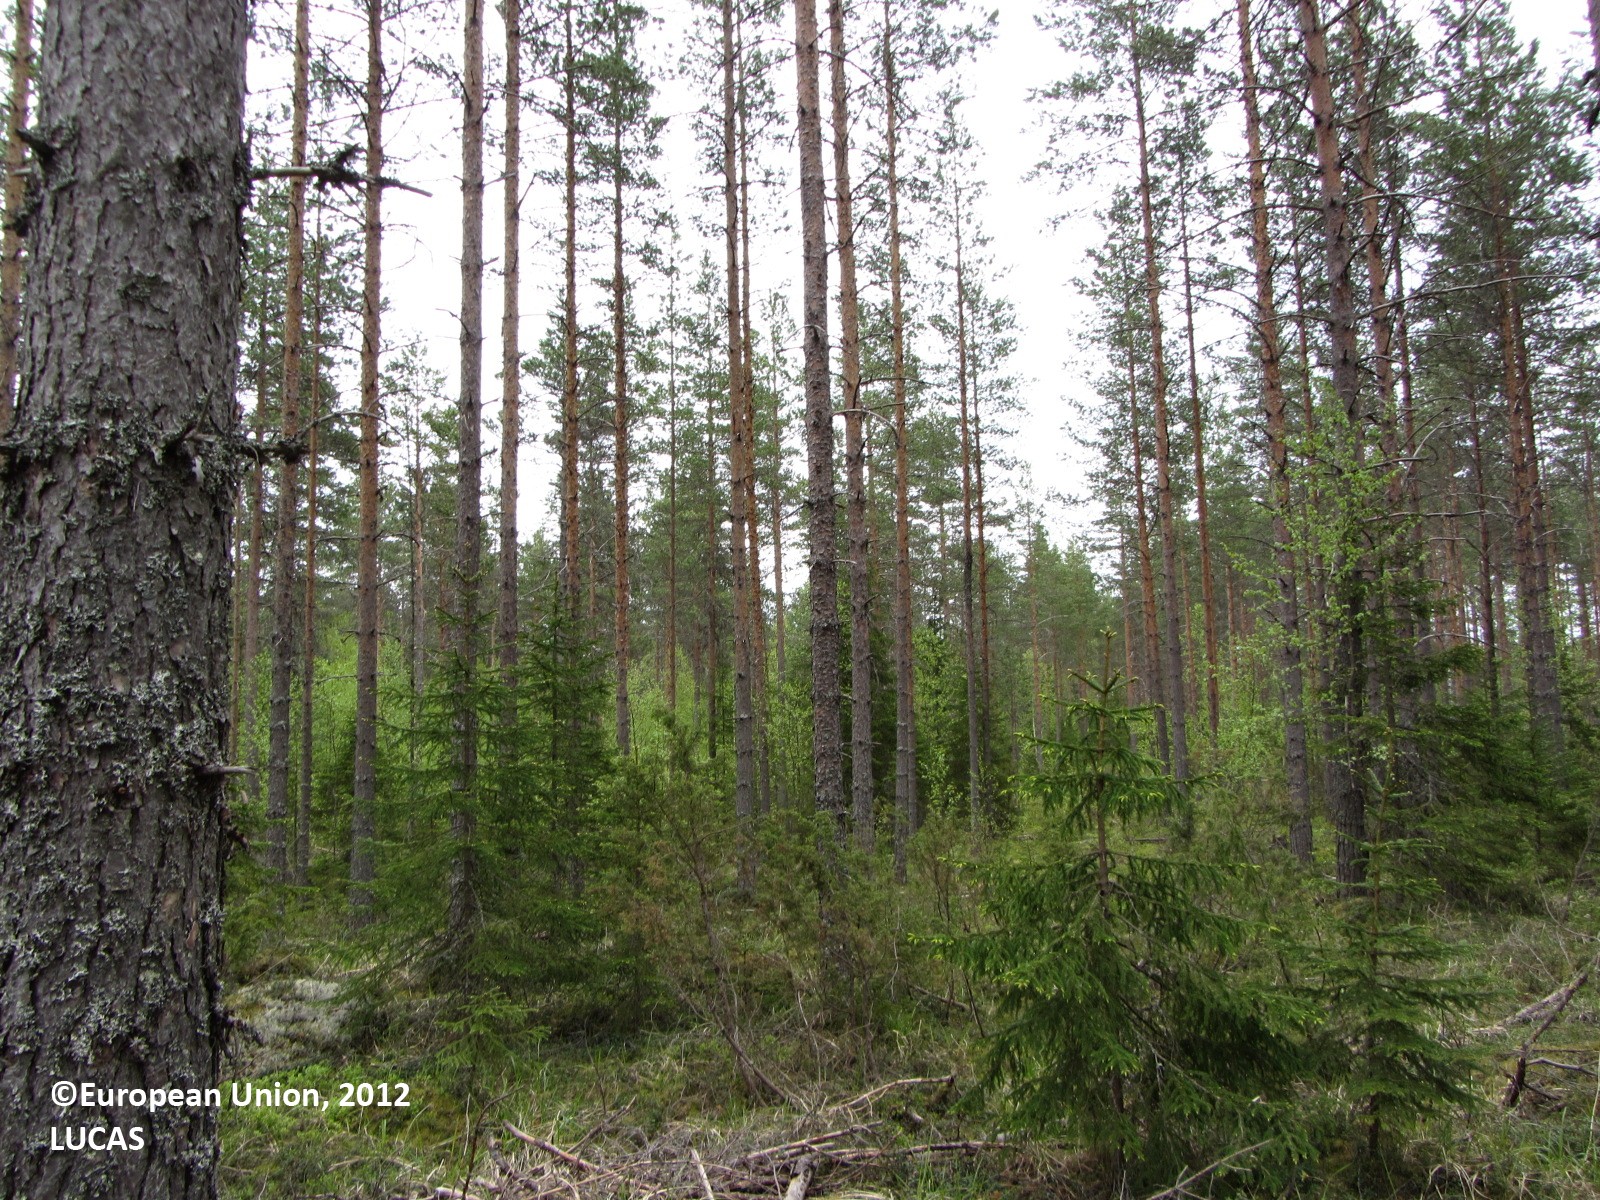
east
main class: Woodland
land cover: Pine dominated mixed woodland
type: boreal forest
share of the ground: > 75 %
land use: Forestry
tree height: > 5 m
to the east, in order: Pine dominated mixed woodland; Rocks and stones; Pine dominated mixed woodland; Ditches and canals; Pine dominated mixed woodland; Spruce dominated mixed woodland; Pine dominated mixed woodland; Spruce dominated coniferous woodland; Pine dominated mixed woodland; Pine dominated coniferous woodland
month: May
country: FI
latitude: 62.3314
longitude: 25.3798
